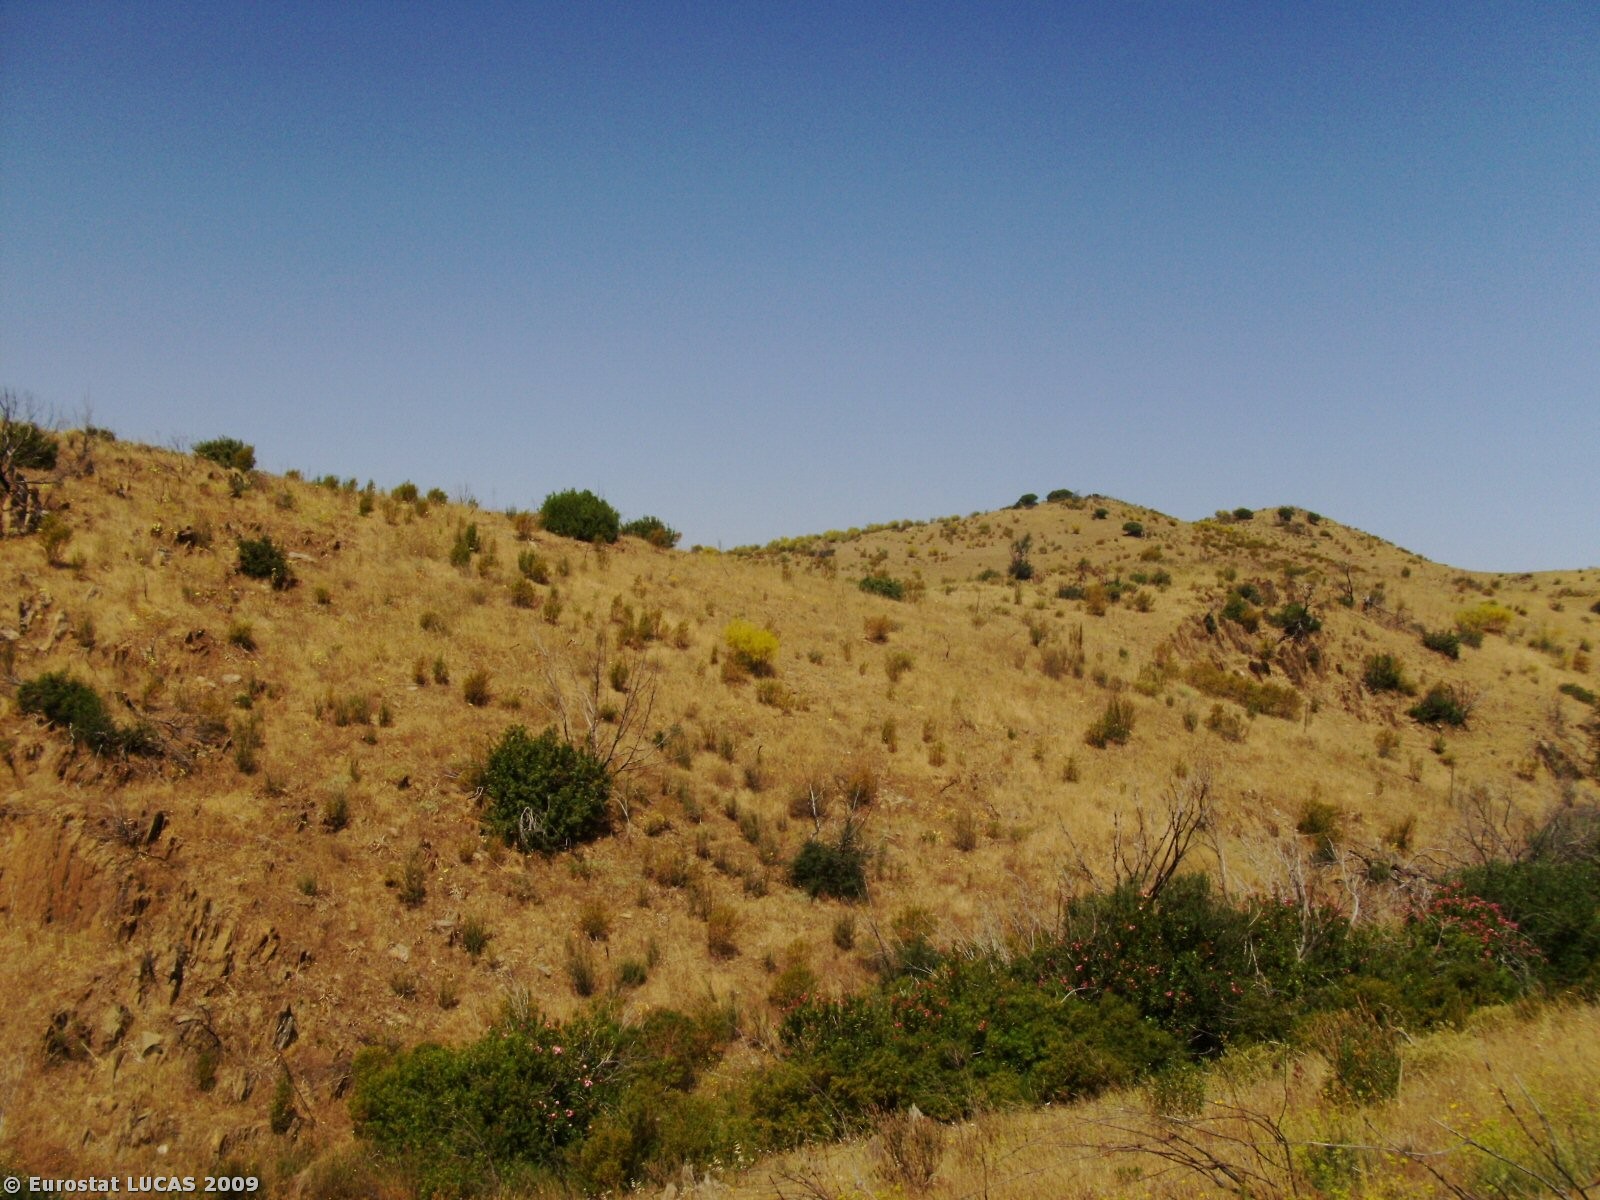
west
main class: Shrubland
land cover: Shrubland without tree cover
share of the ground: 50 - 75 %
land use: Agriculture (excluding fallow land and kitchen gardens)
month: May
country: PT
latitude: 37.6129
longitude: -7.6767
